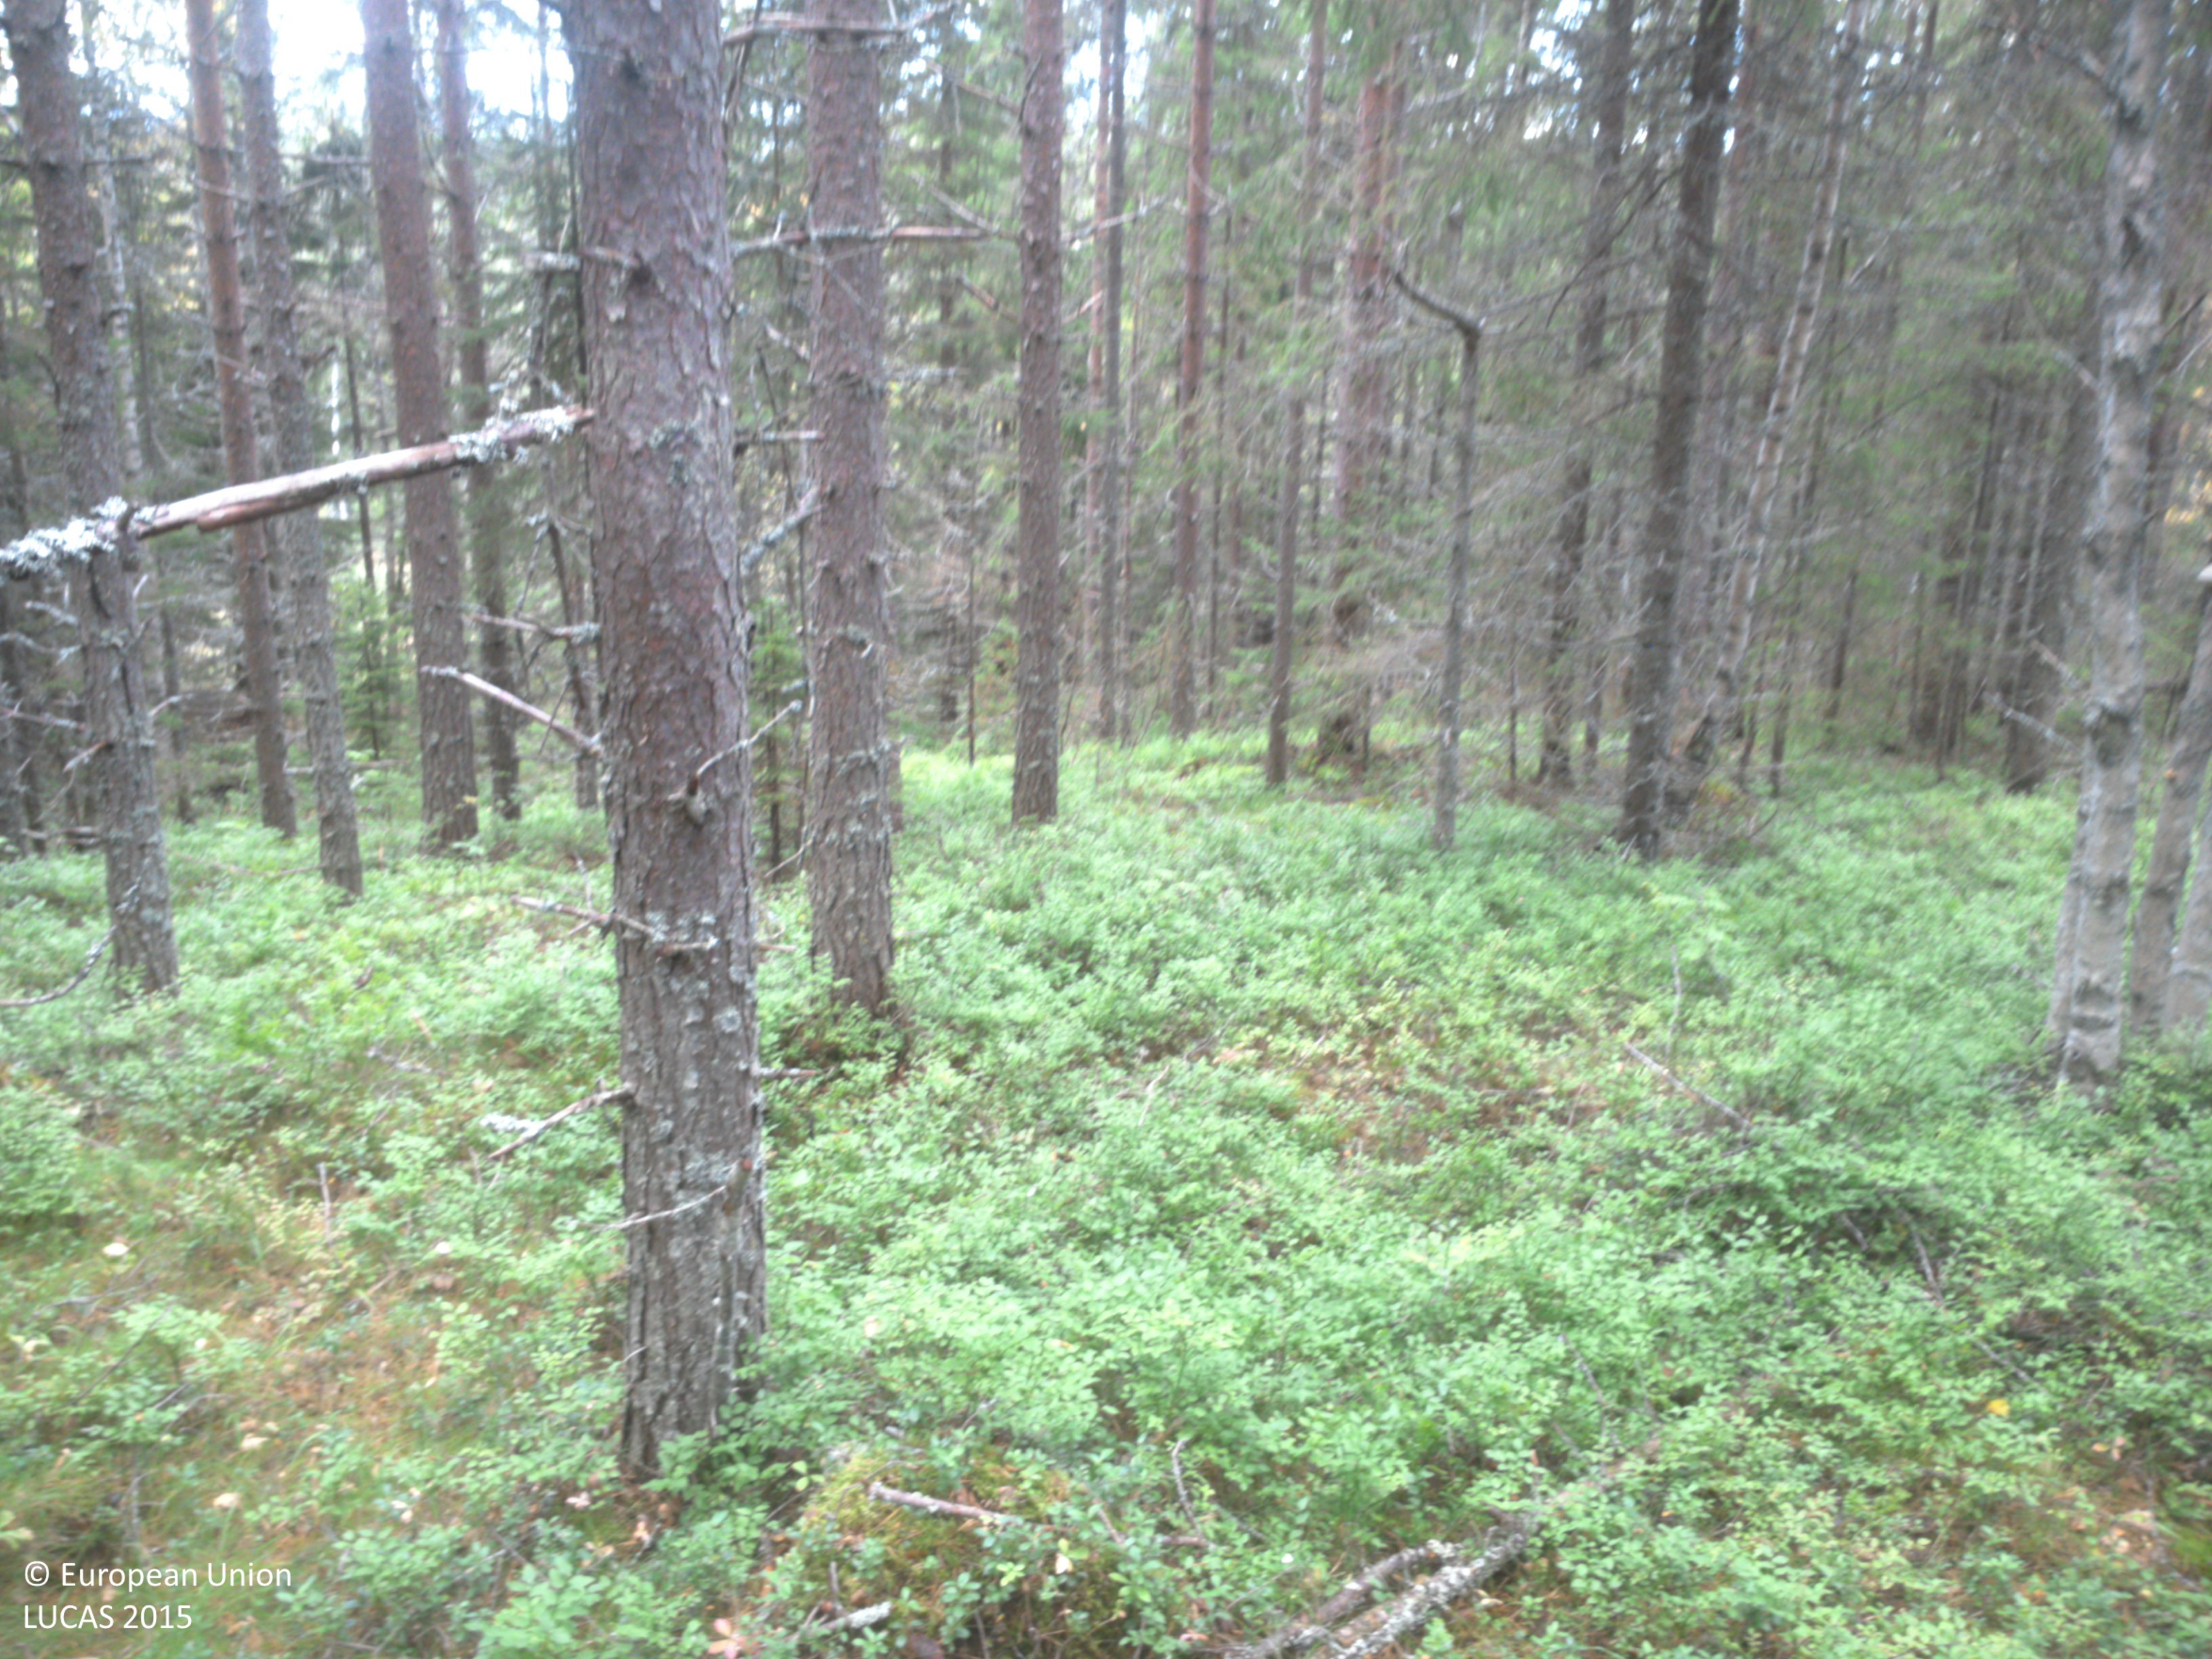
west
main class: Woodland
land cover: Pine dominated mixed woodland
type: boreal forest
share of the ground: 50 - 75 %
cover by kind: shrubs 45 %, coniferous forest trees 40 %, broadleaved forest trees 15 %
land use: Forestry
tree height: > 5 m
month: August
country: SE
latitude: 63.8473
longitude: 19.9642
